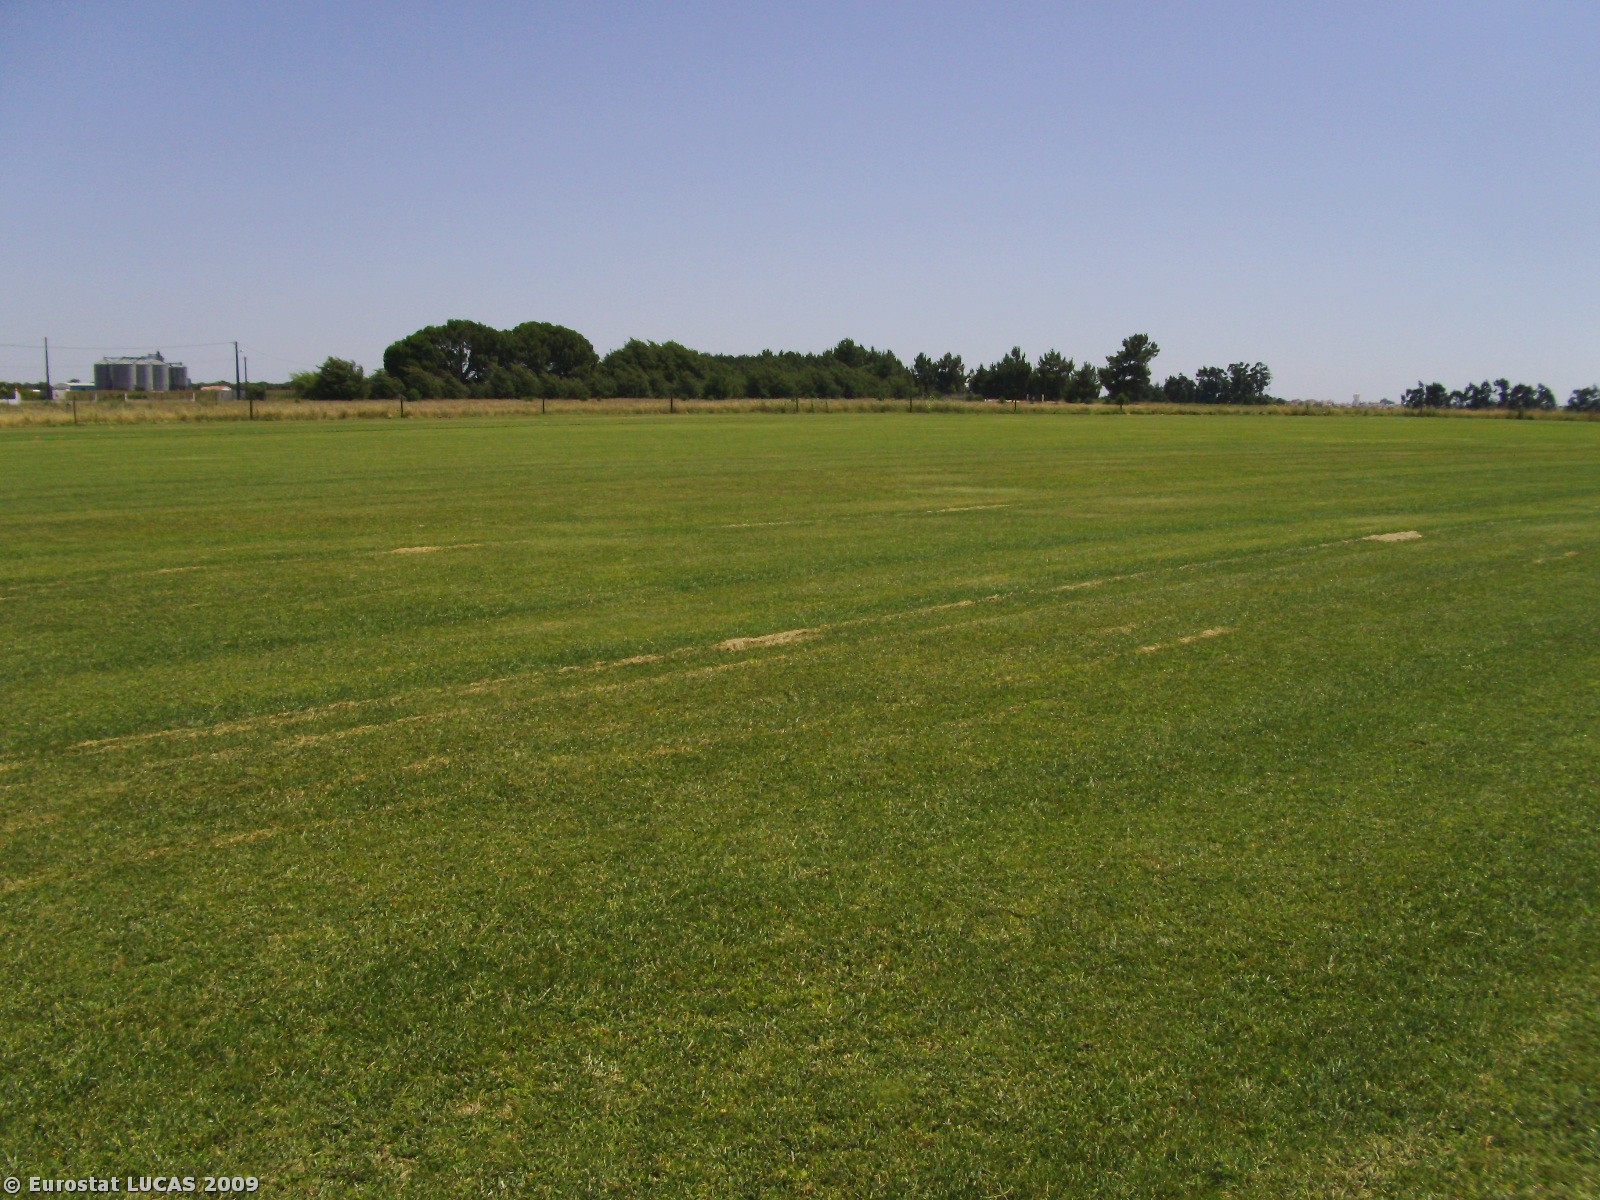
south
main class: Cropland
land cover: Temporary grasslands
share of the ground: > 75 %
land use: Agriculture (excluding fallow land and kitchen gardens)
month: July
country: PT
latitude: 39.0073
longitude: -8.7901
